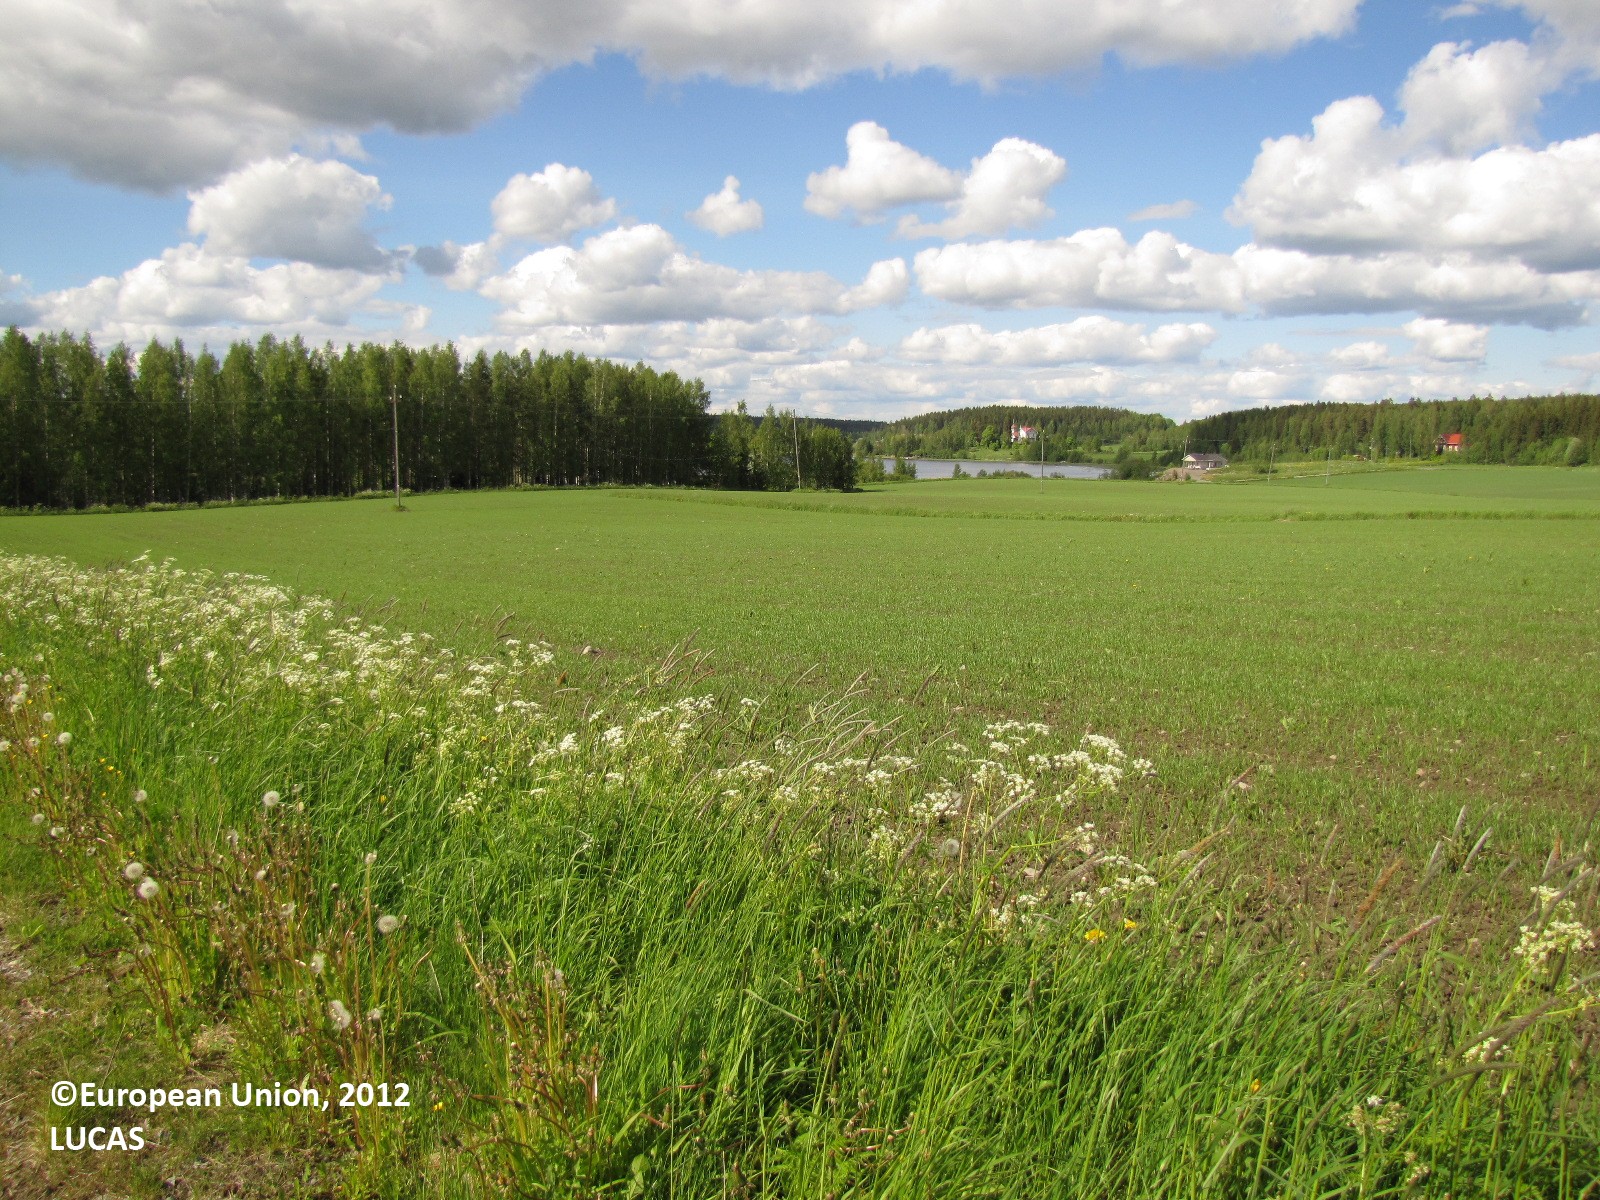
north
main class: Cropland
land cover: Common wheat
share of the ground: 50 - 75 %
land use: Agriculture (excluding fallow land and kitchen gardens)
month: June
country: FI
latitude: 61.4357
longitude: 23.0649
